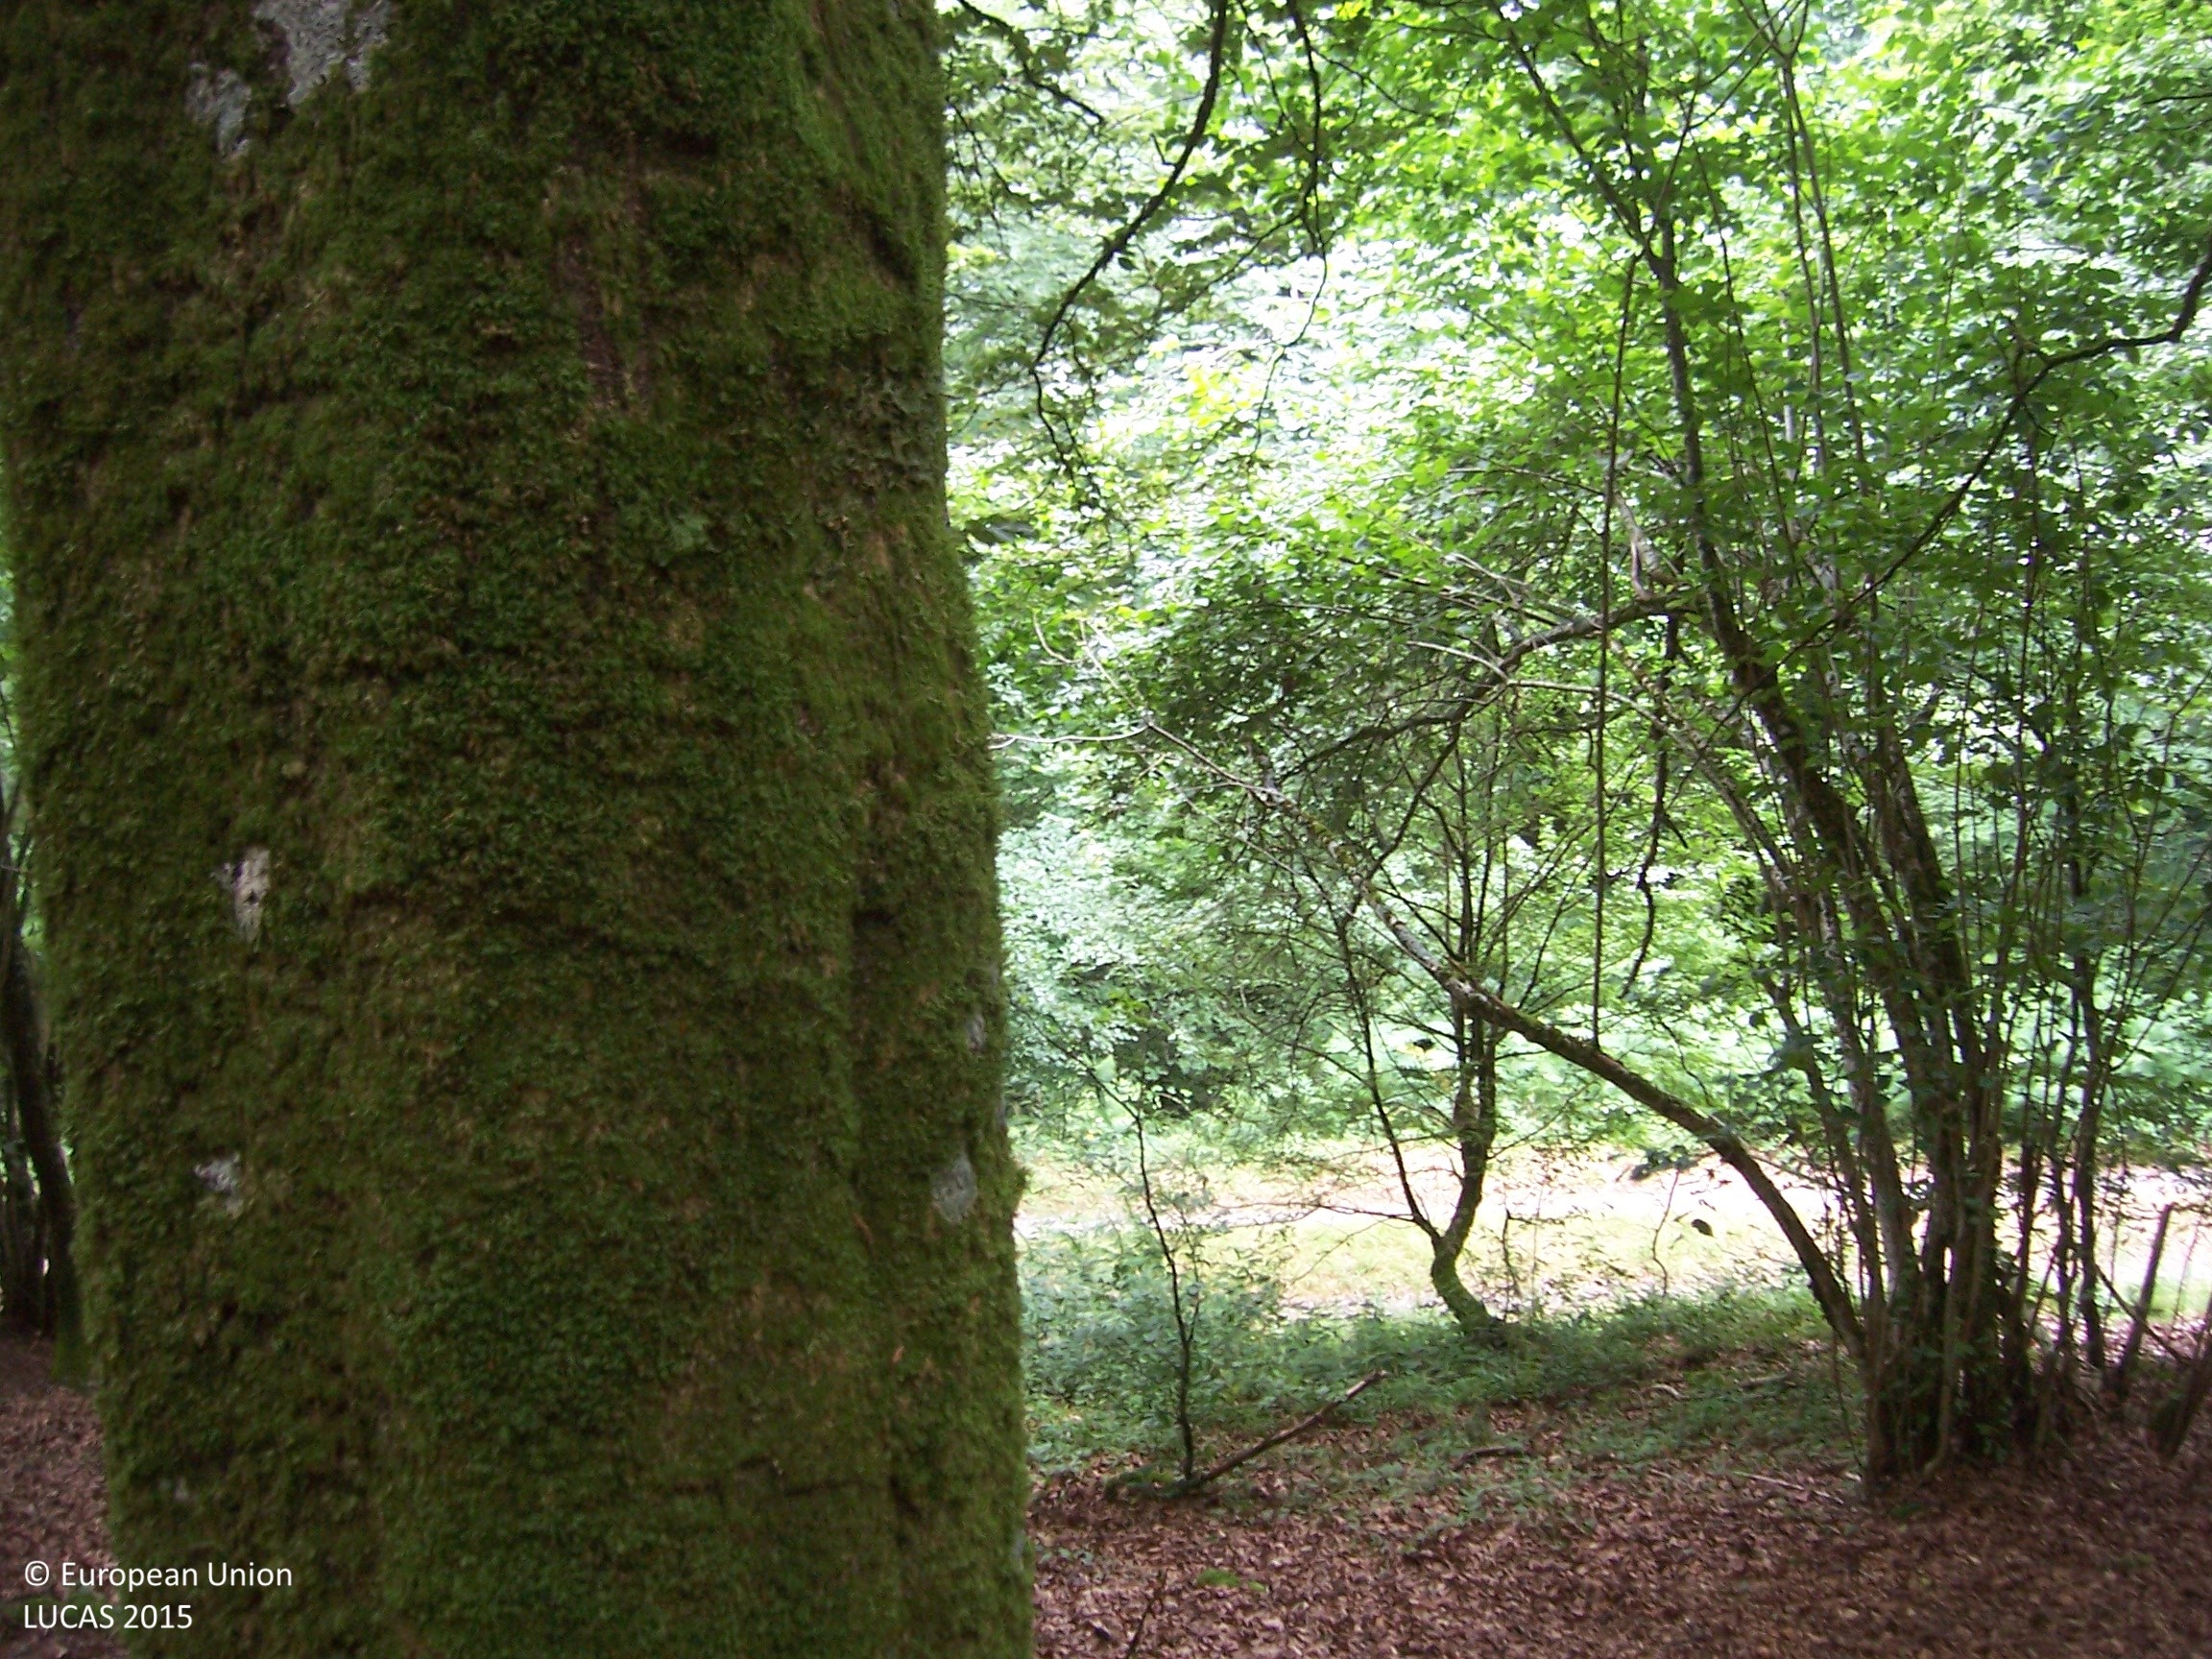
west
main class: Woodland
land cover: Broadleaved woodland
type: mountainous beech forest
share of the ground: > 75 %
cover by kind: broadleaved forest trees 100 %
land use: Forestry
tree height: > 5 m
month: July
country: ES
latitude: 43.0127
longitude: -1.2138
